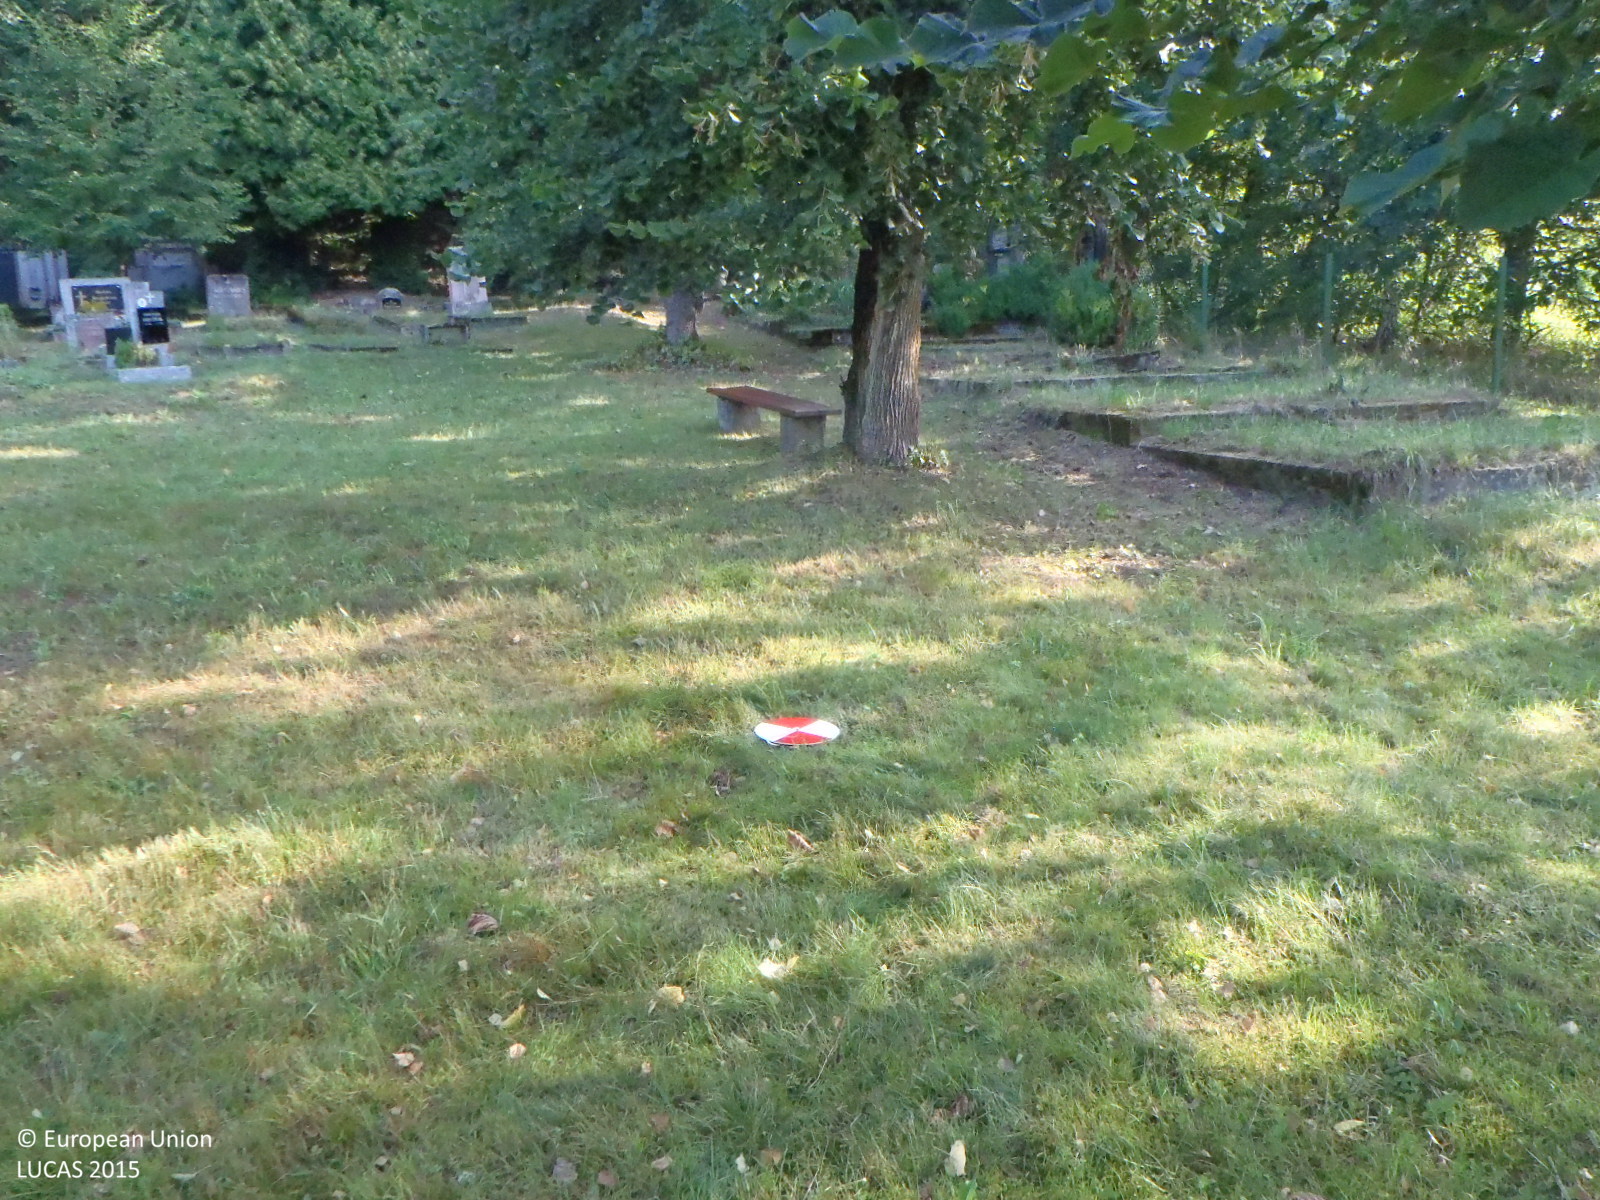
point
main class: Woodland
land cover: Broadleaved woodland
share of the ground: 25 - 50 %
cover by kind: herbaceous plants 60 %, broadleaved forest trees 40 %
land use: Community services
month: August
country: CZ
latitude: 50.7586
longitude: 14.5809
